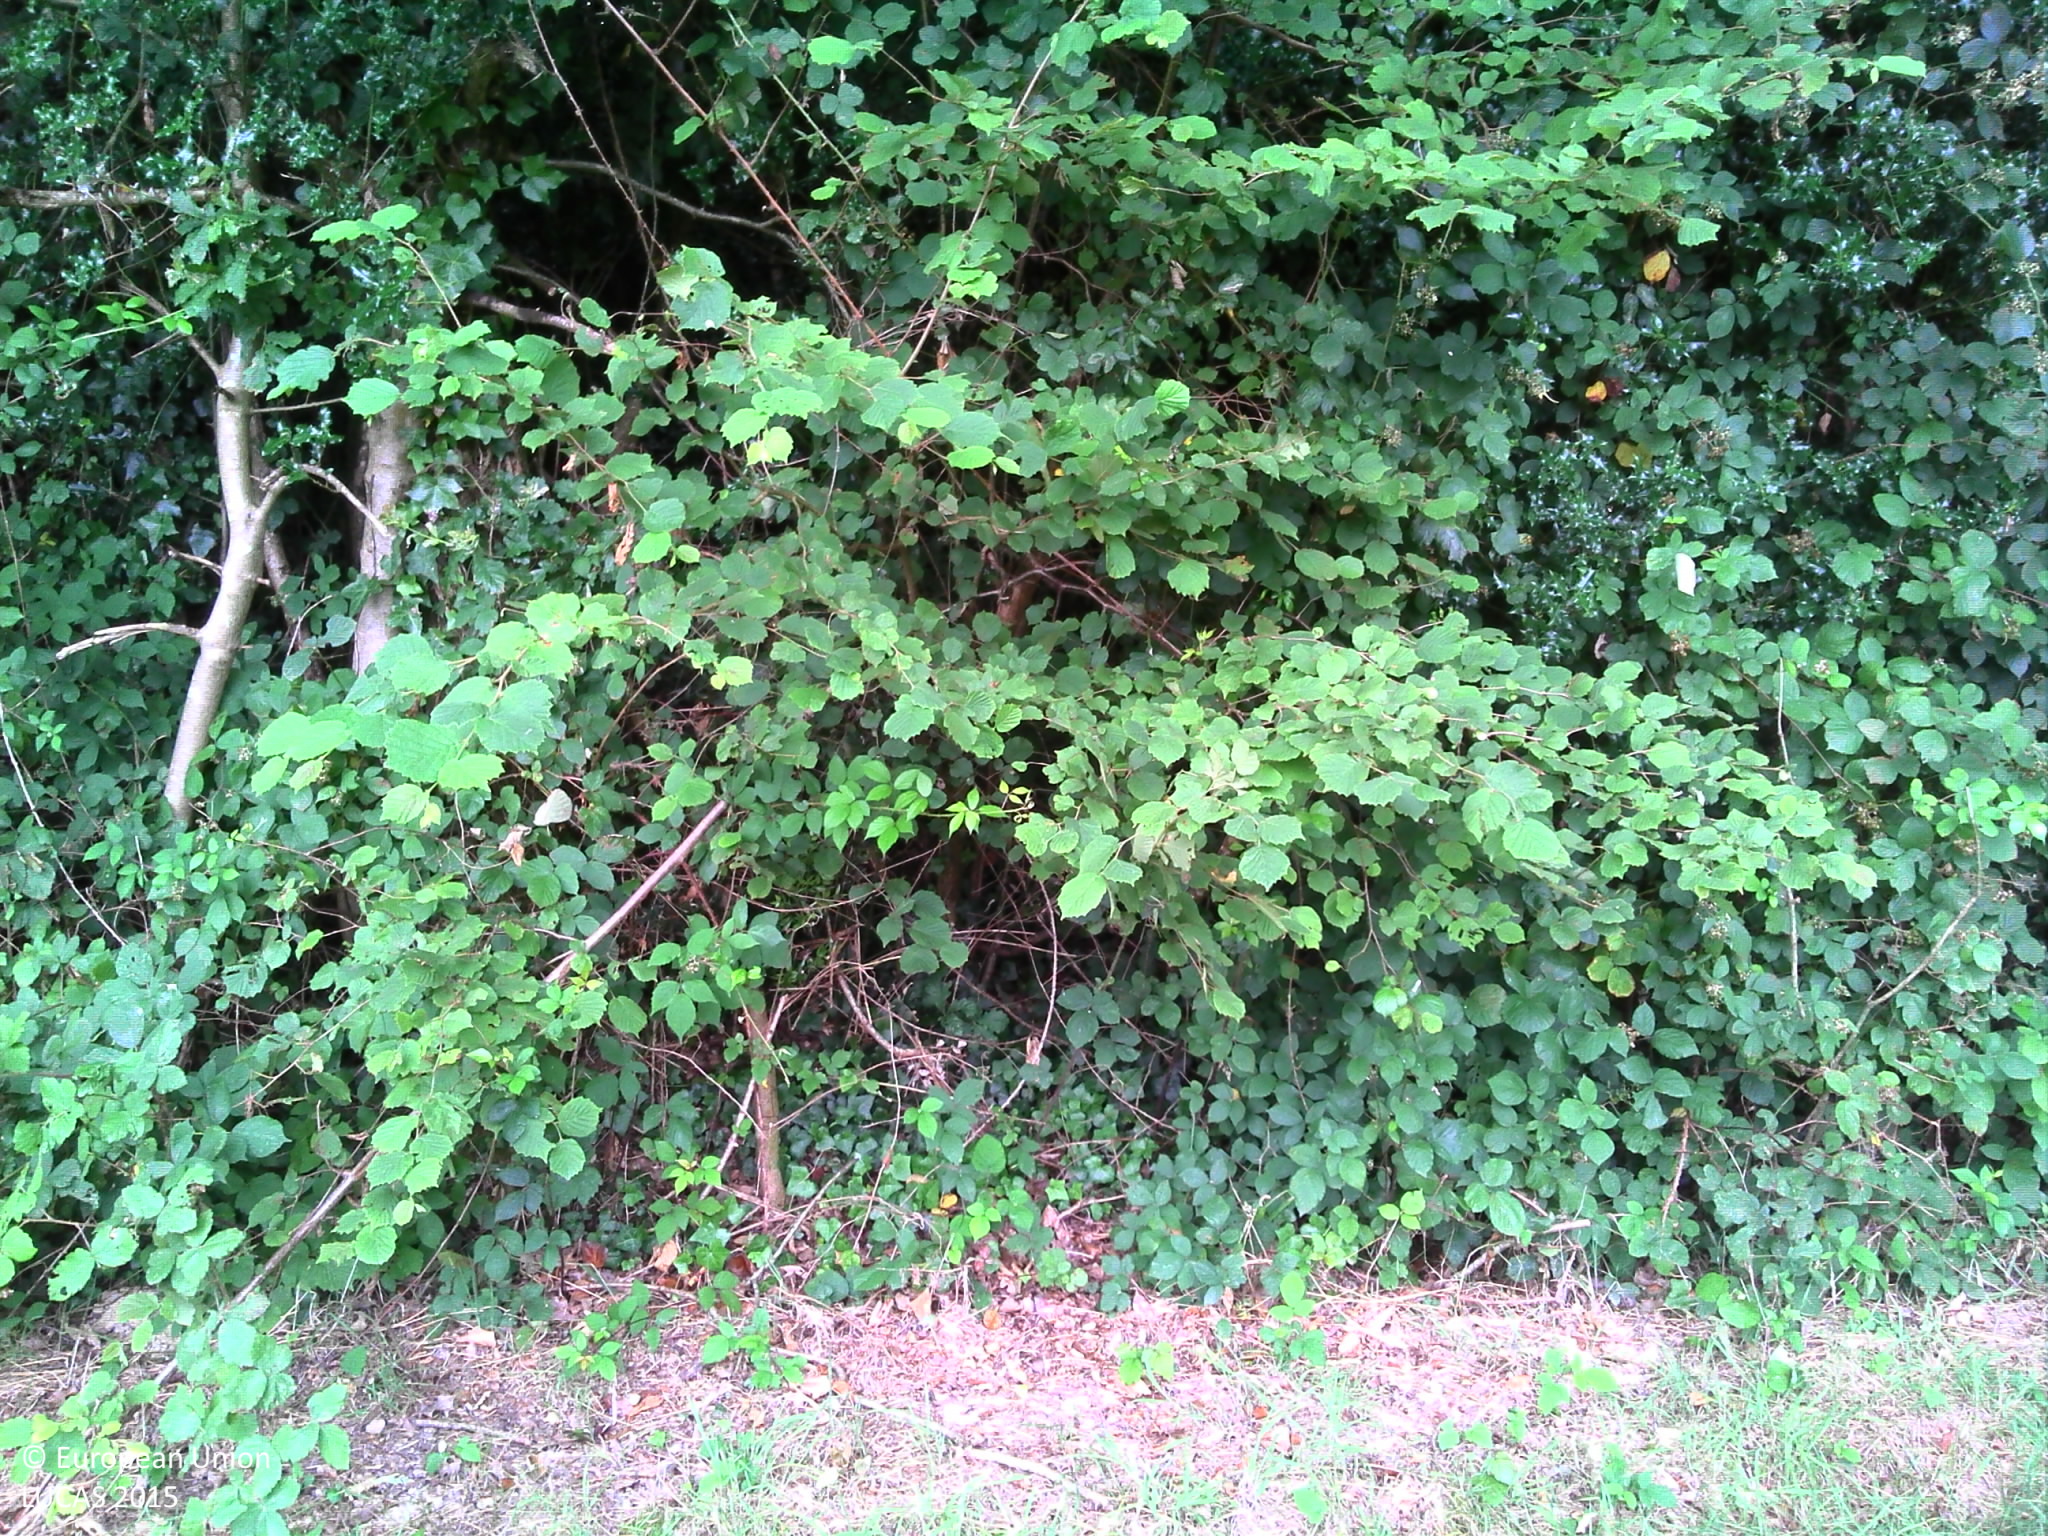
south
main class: Grassland
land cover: Grassland without tree/shrub cover
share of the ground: > 75 %
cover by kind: herbaceous plants 100 %
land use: Road transport
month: July
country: FR
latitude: 47.0299
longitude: -1.7415
